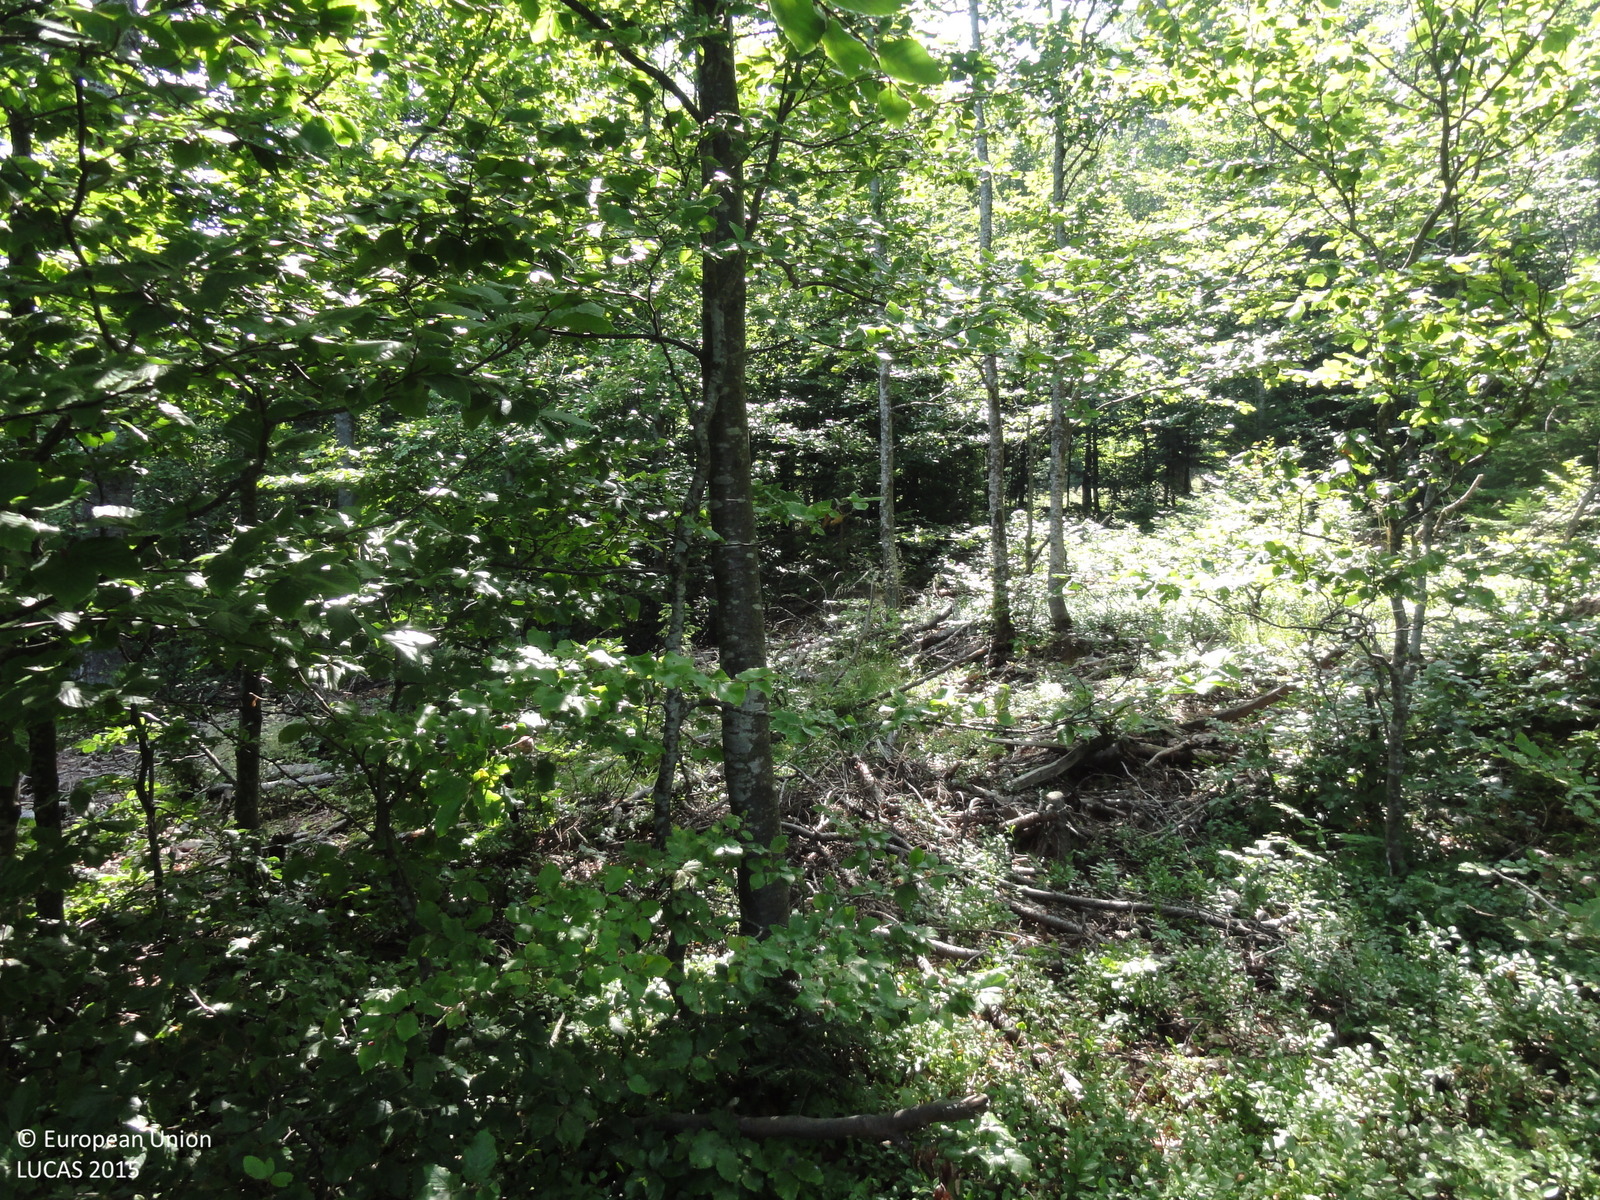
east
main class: Woodland
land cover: Other mixed woodland
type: mountainous beech forest
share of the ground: > 75 %
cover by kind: coniferous forest trees 65 %, broadleaved forest trees 25 %, shrubs 5 %, herbaceous plants 5 %
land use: Forestry
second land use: Amenities, museums, leisure
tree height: > 5 m
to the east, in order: Other mixed woodland; Spruce dominated mixed woodland
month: July
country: SI
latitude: 46.4993
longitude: 15.4843
